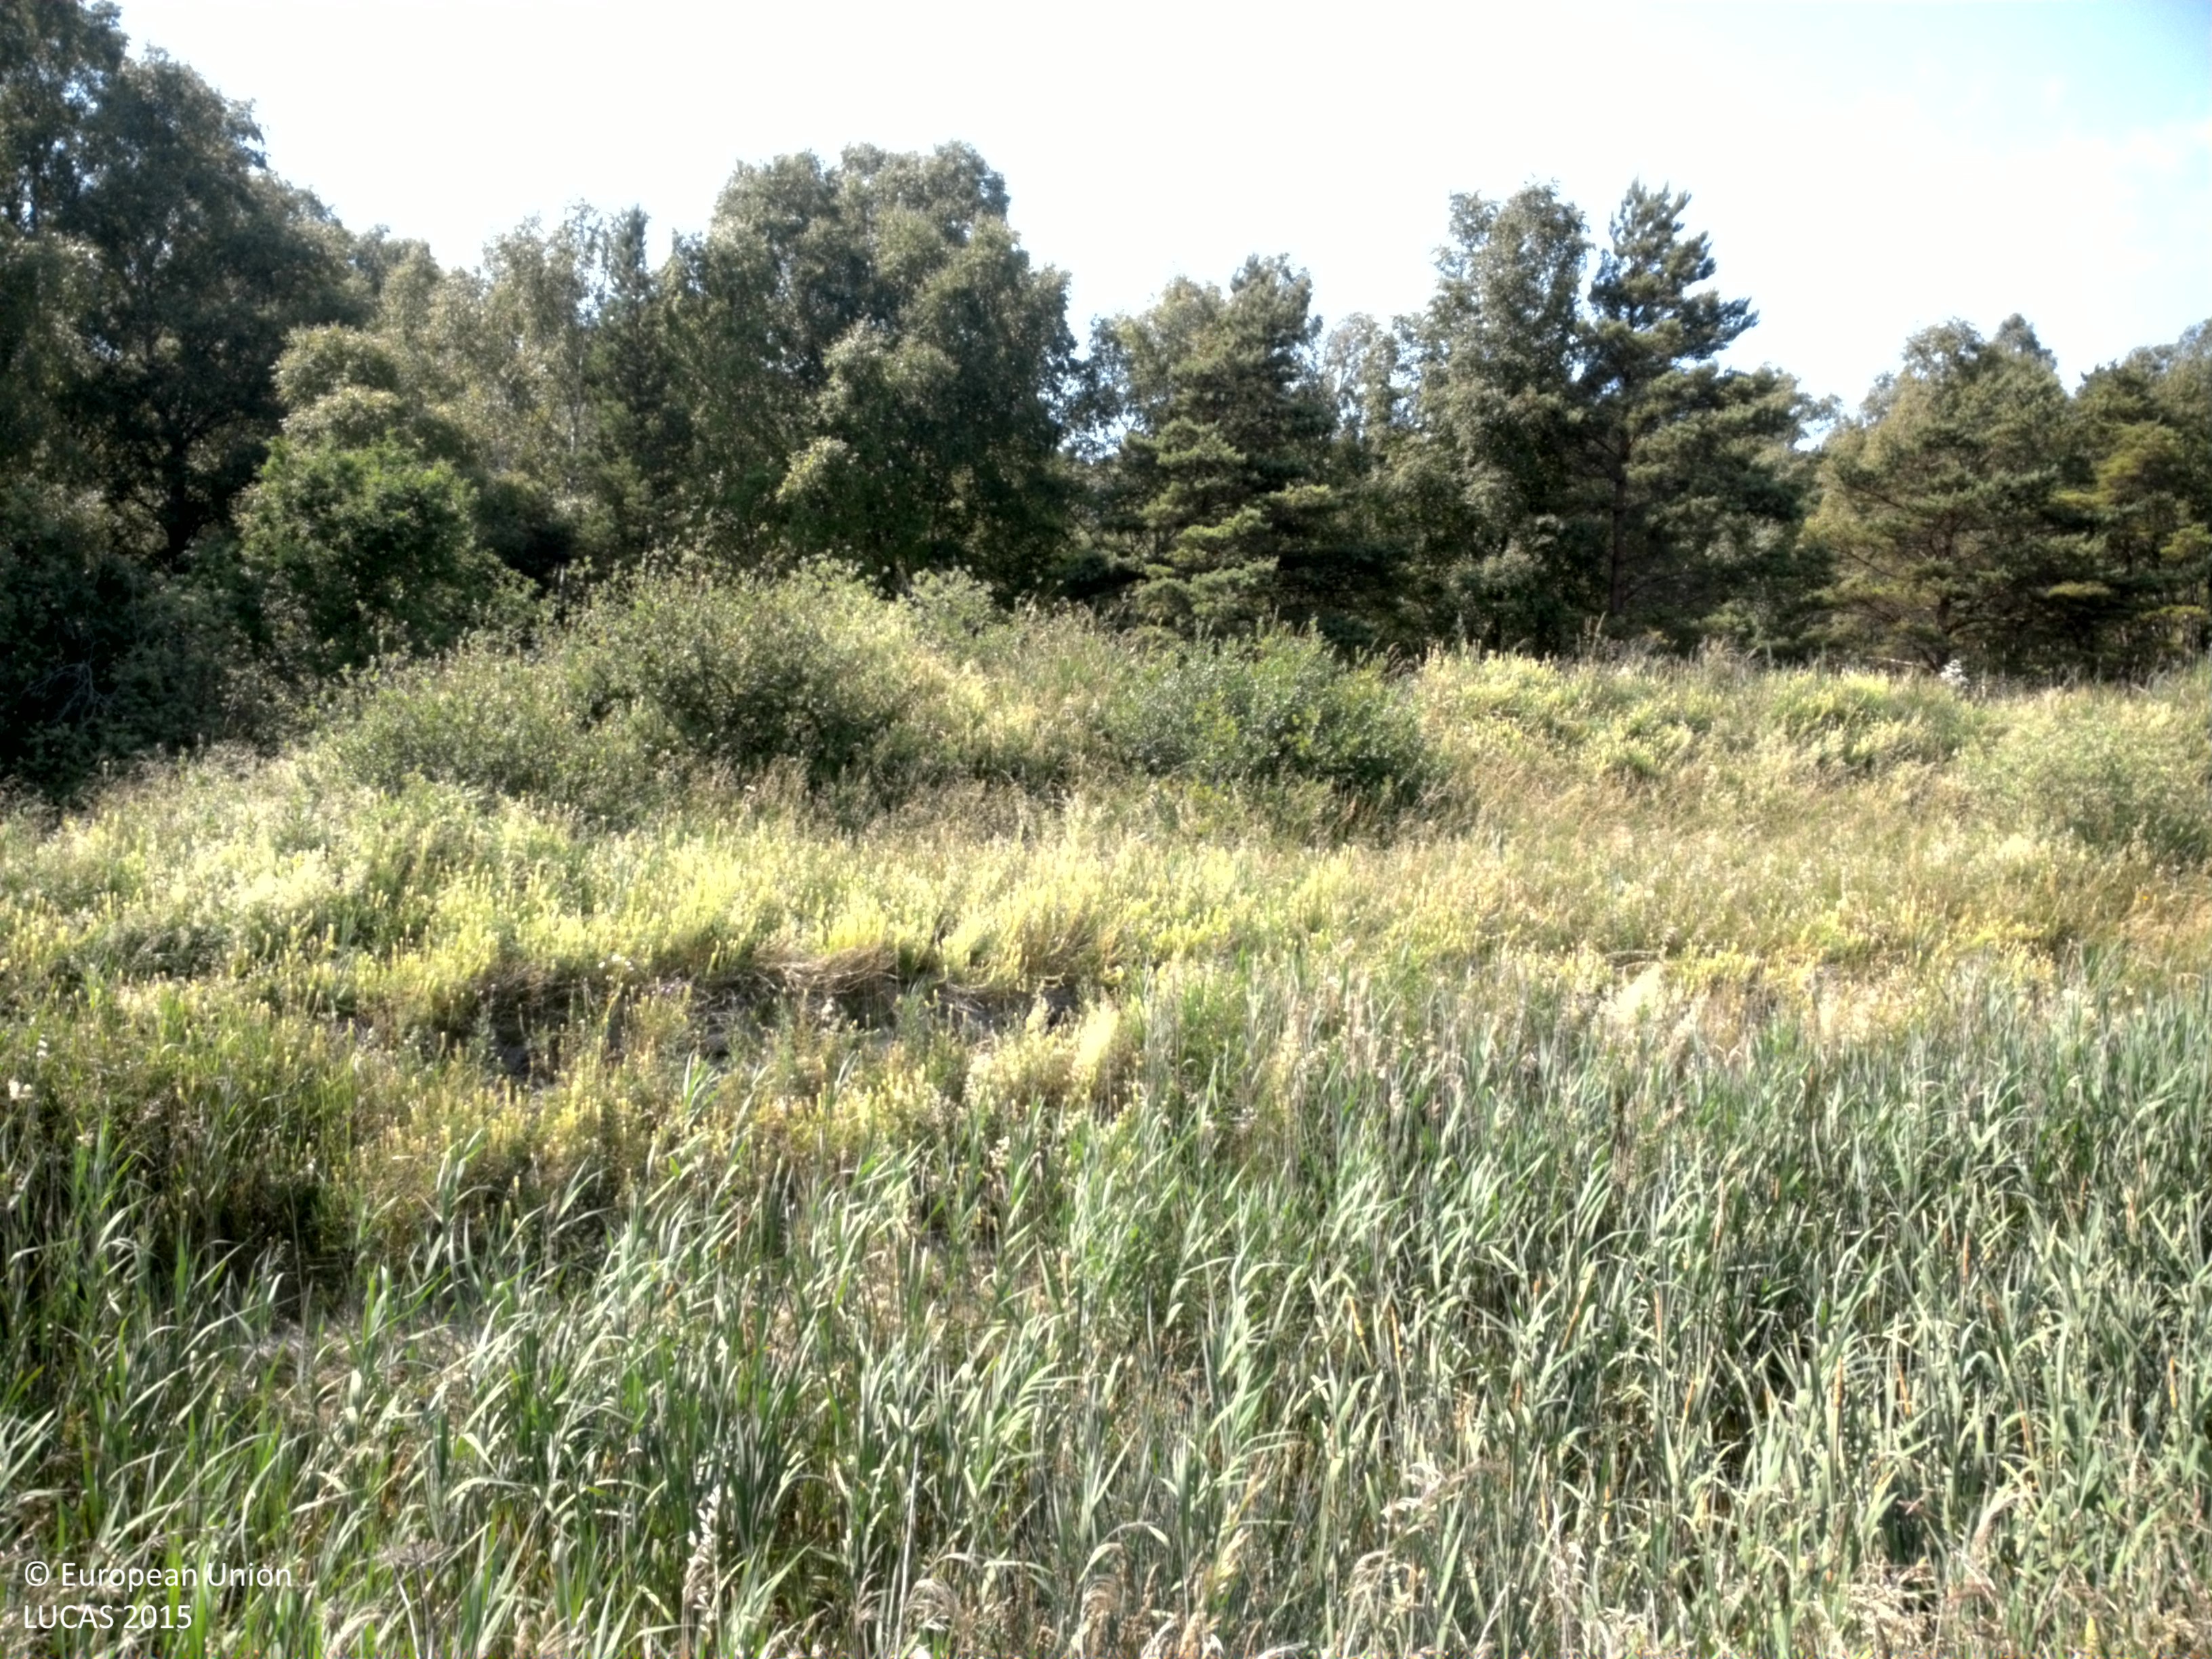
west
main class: Grassland
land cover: Spontaneously vegetated surfaces
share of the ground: > 75 %
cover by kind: herbaceous plants 95 %, shrubs 5 %
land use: Agriculture (excluding fallow land and kitchen gardens)
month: July
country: SE
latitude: 57.7293
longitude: 18.5556
